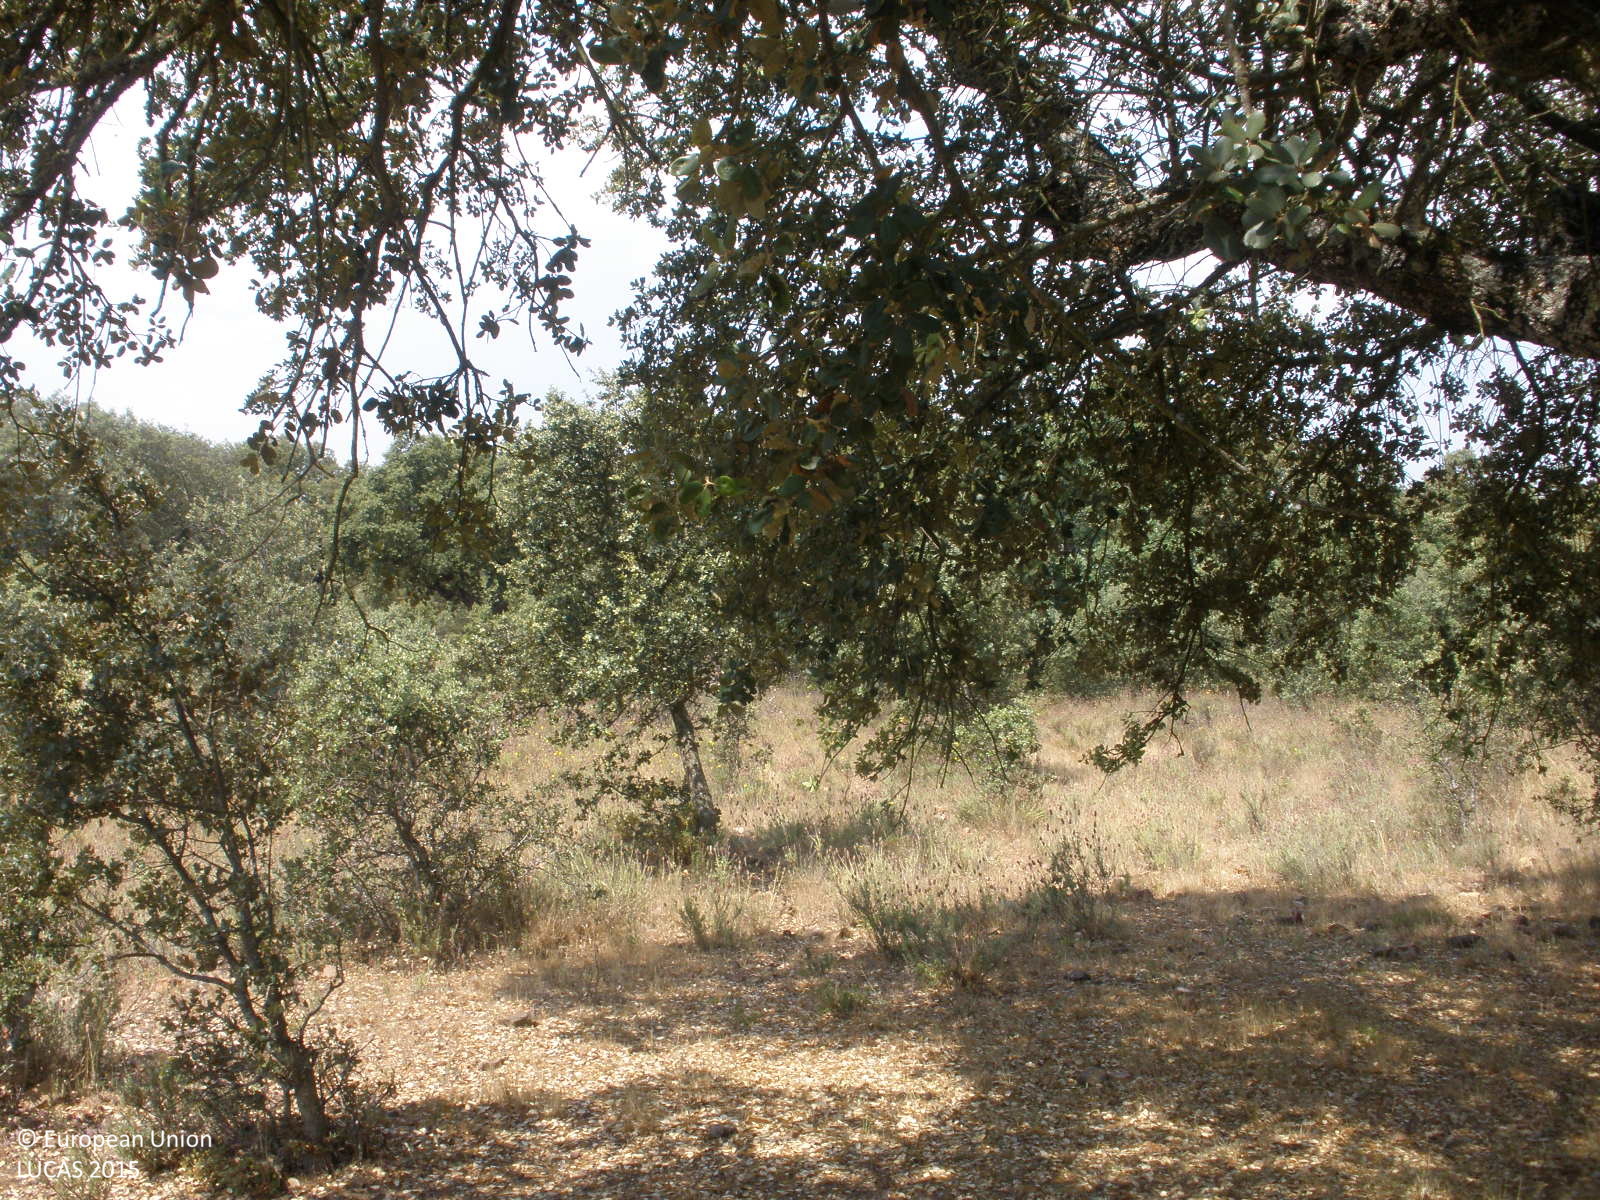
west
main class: Woodland
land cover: Broadleaved woodland
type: broadleaved evergreen forest
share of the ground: > 75 %
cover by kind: broadleaved forest trees 40 %, shrubs 40 %, herbaceous plants 20 %
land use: Forestry
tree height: > 5 m
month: June
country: ES
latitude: 40.6431
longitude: -6.2974
